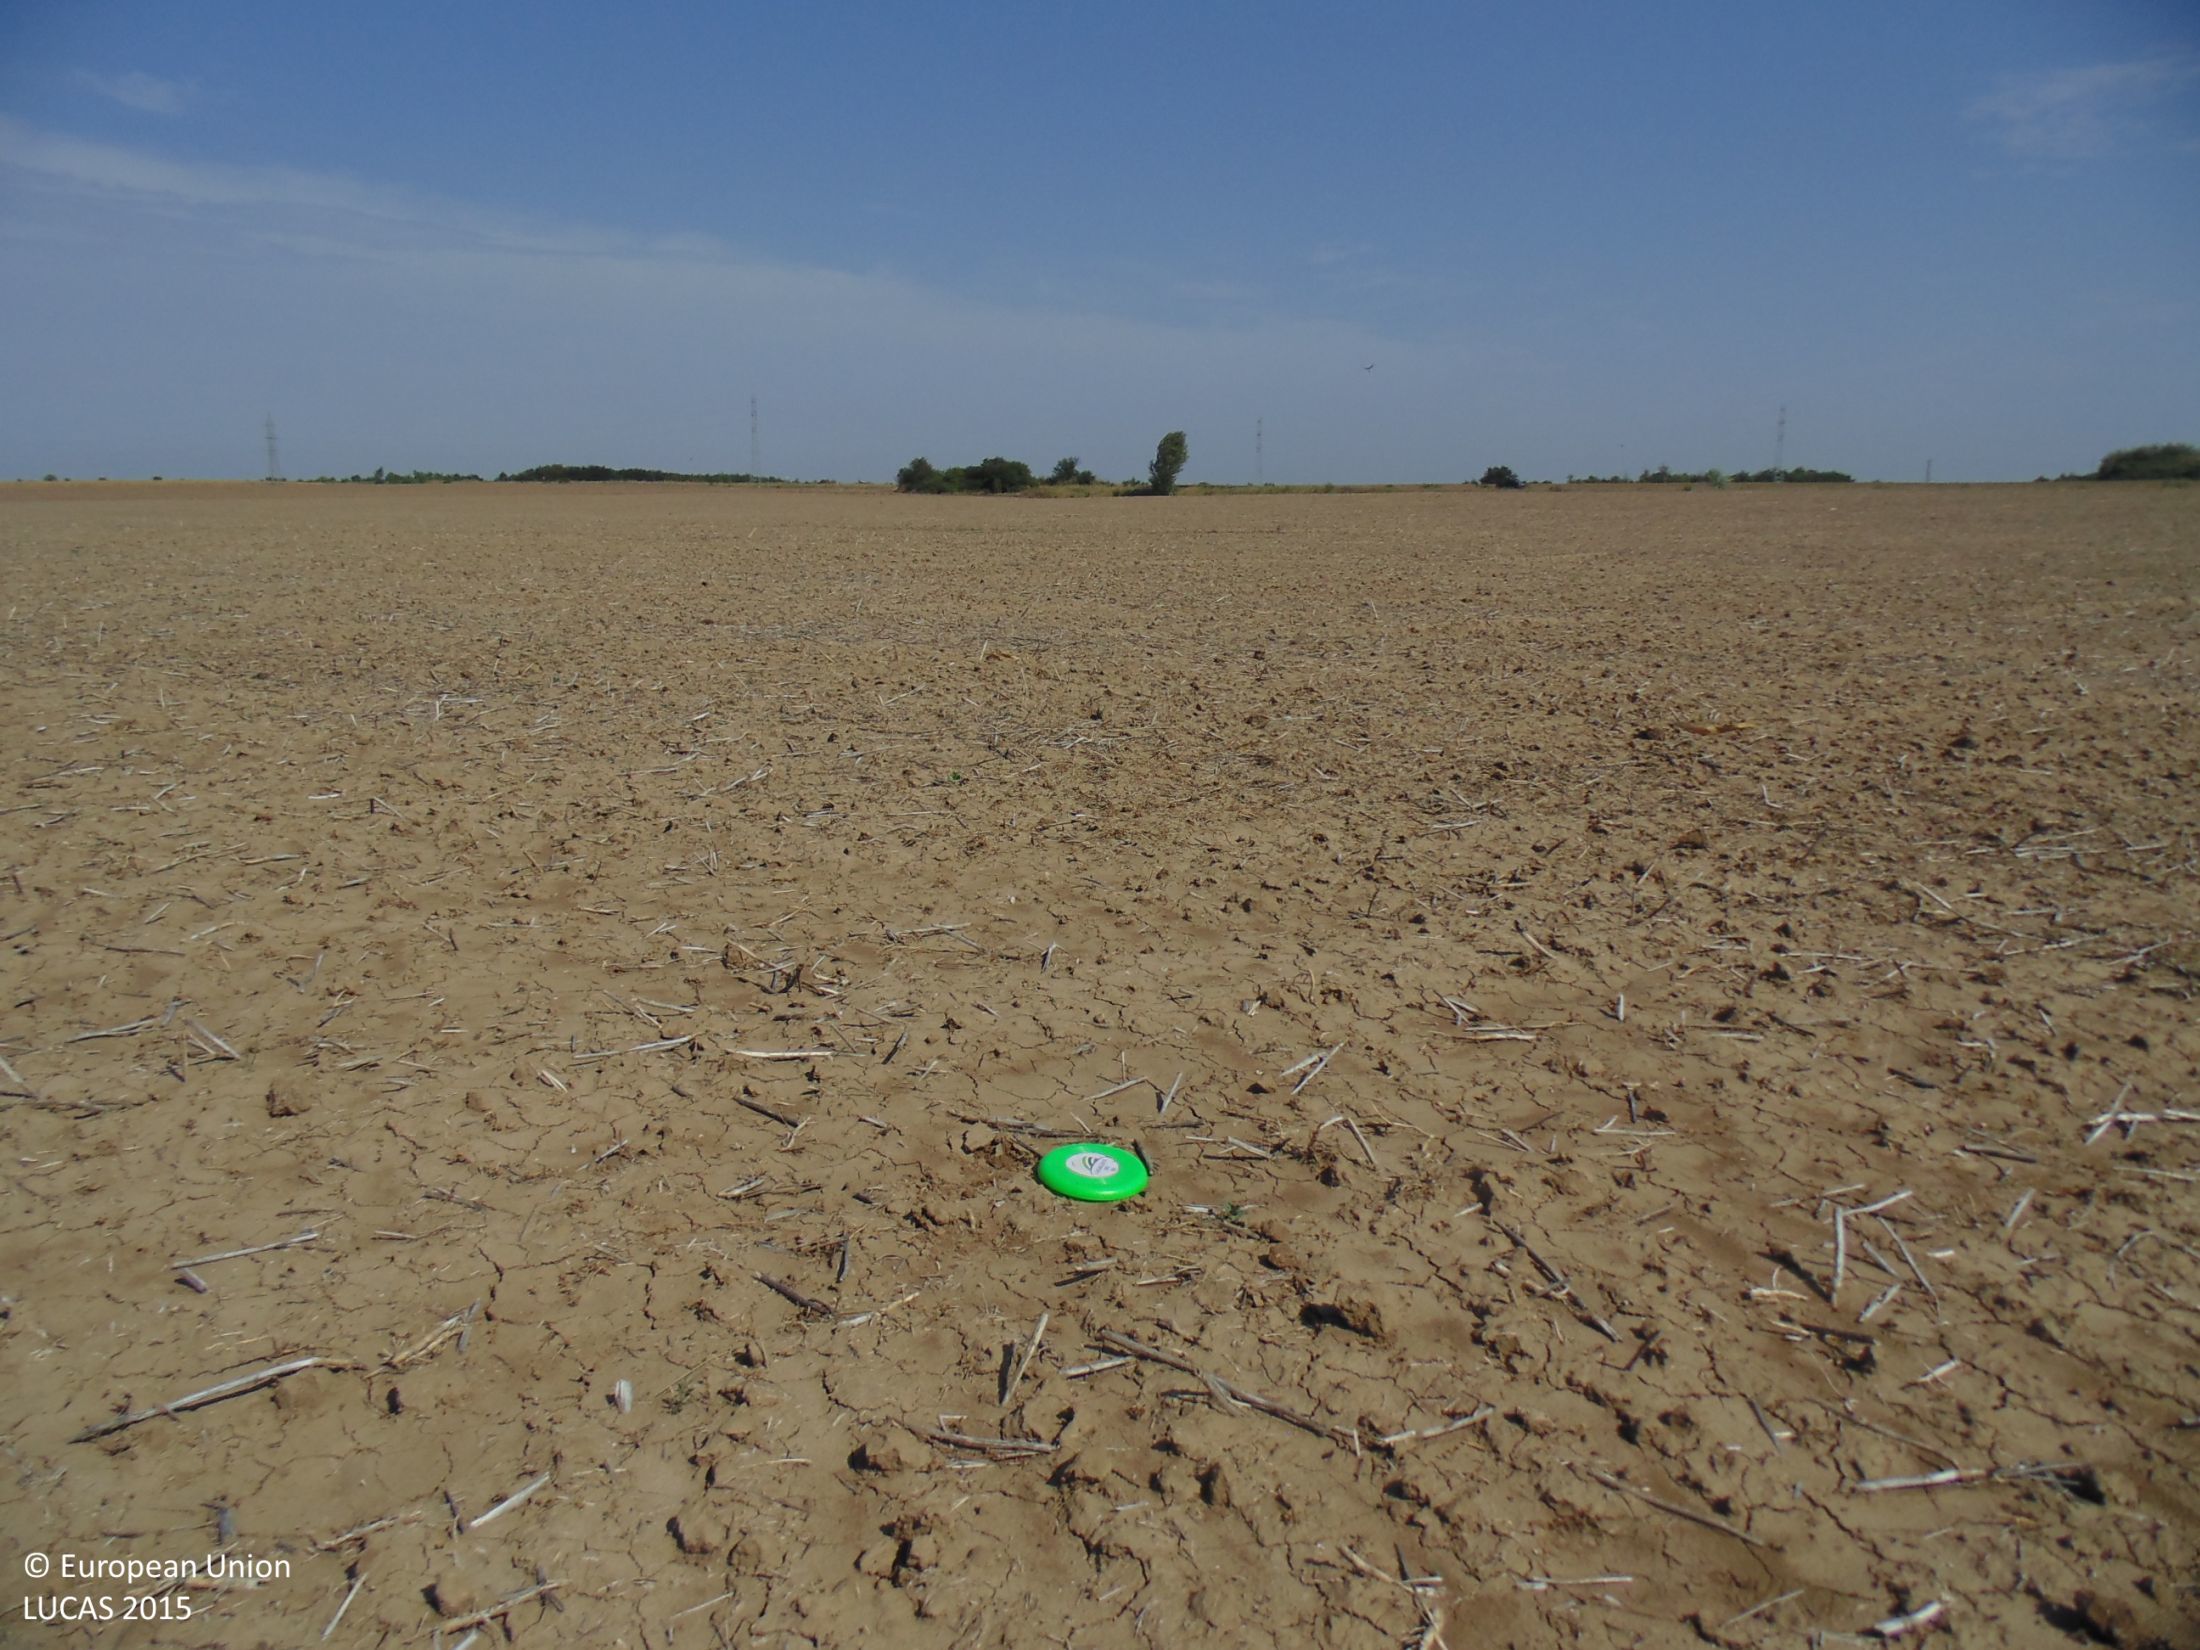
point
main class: Cropland
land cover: Rape and turnip rape
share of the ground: < 10 %
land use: Agriculture (excluding fallow land and kitchen gardens)
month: September
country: BG
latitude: 44.0793
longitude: 27.2001
